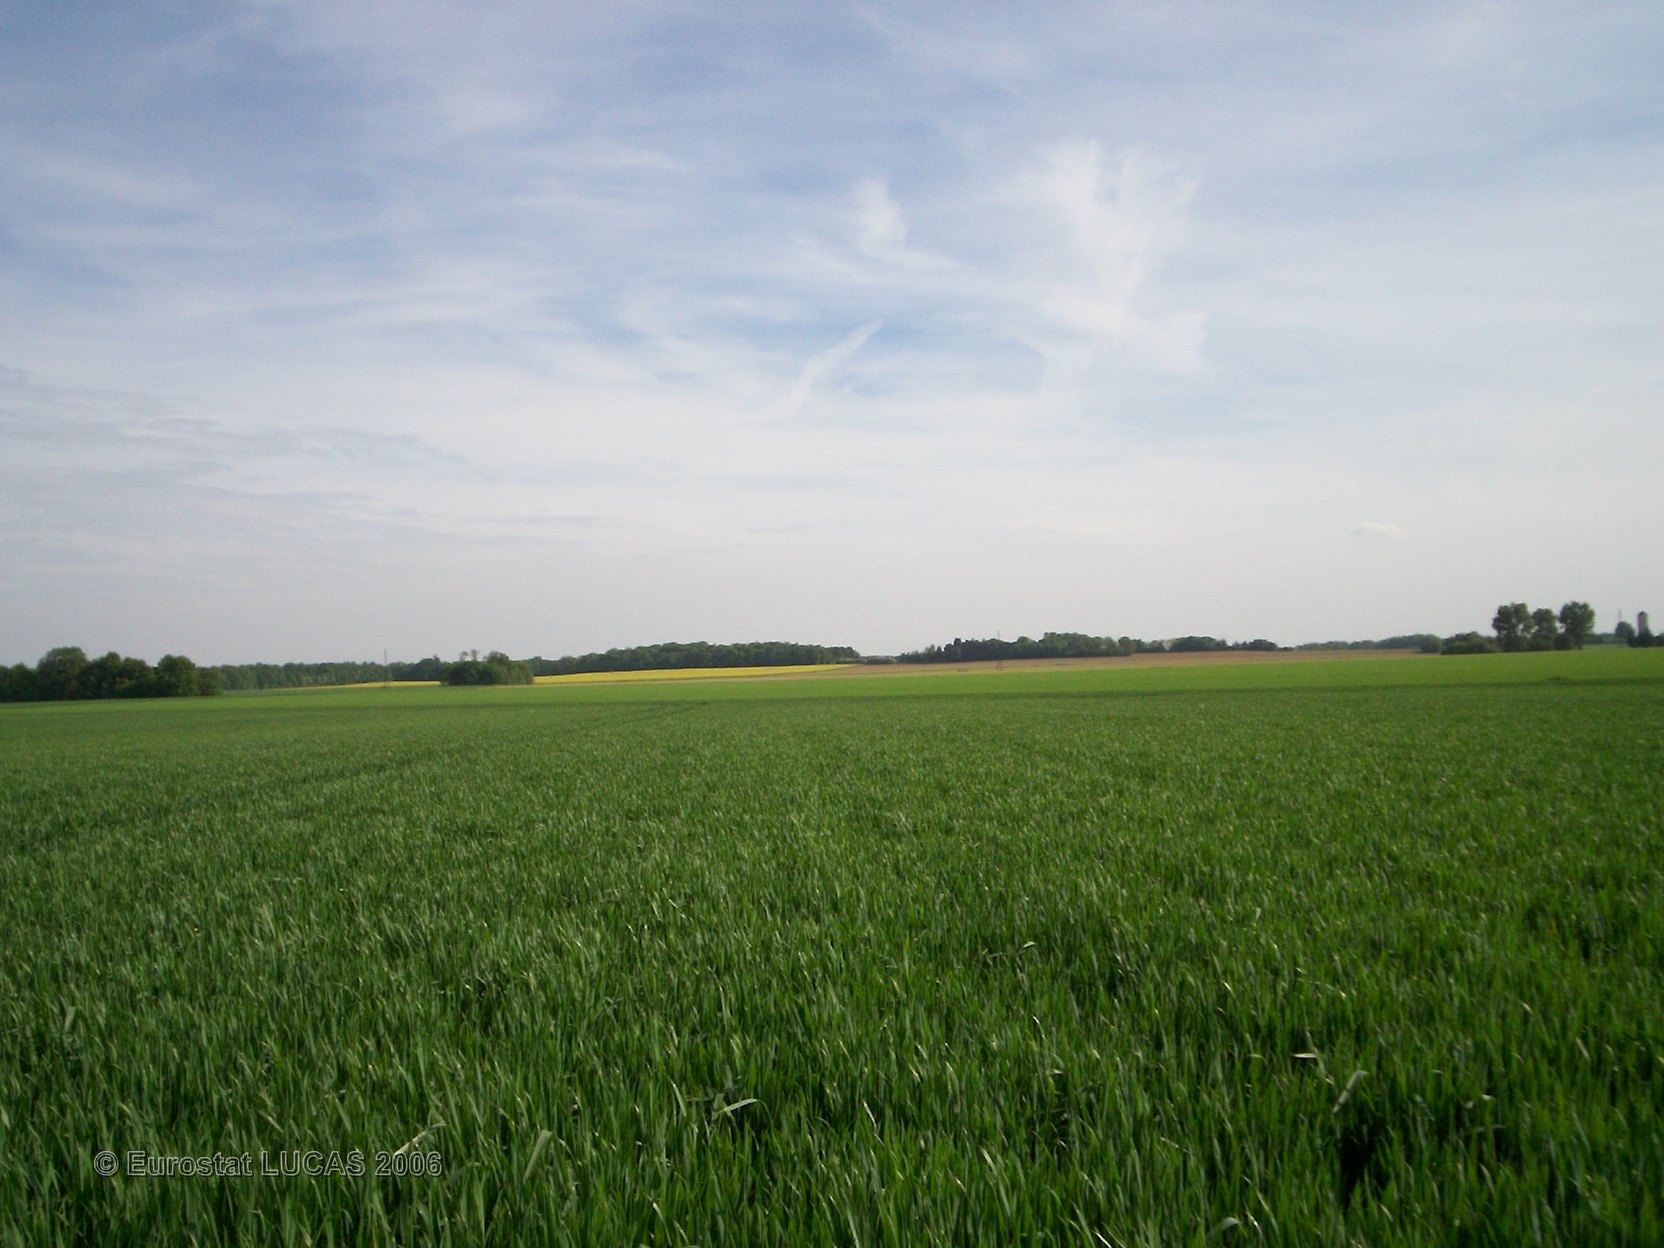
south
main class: Cropland
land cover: Common wheat
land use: Agriculture (excluding fallow land and kitchen gardens)
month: May
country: FR
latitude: 48.5888
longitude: 2.8735
